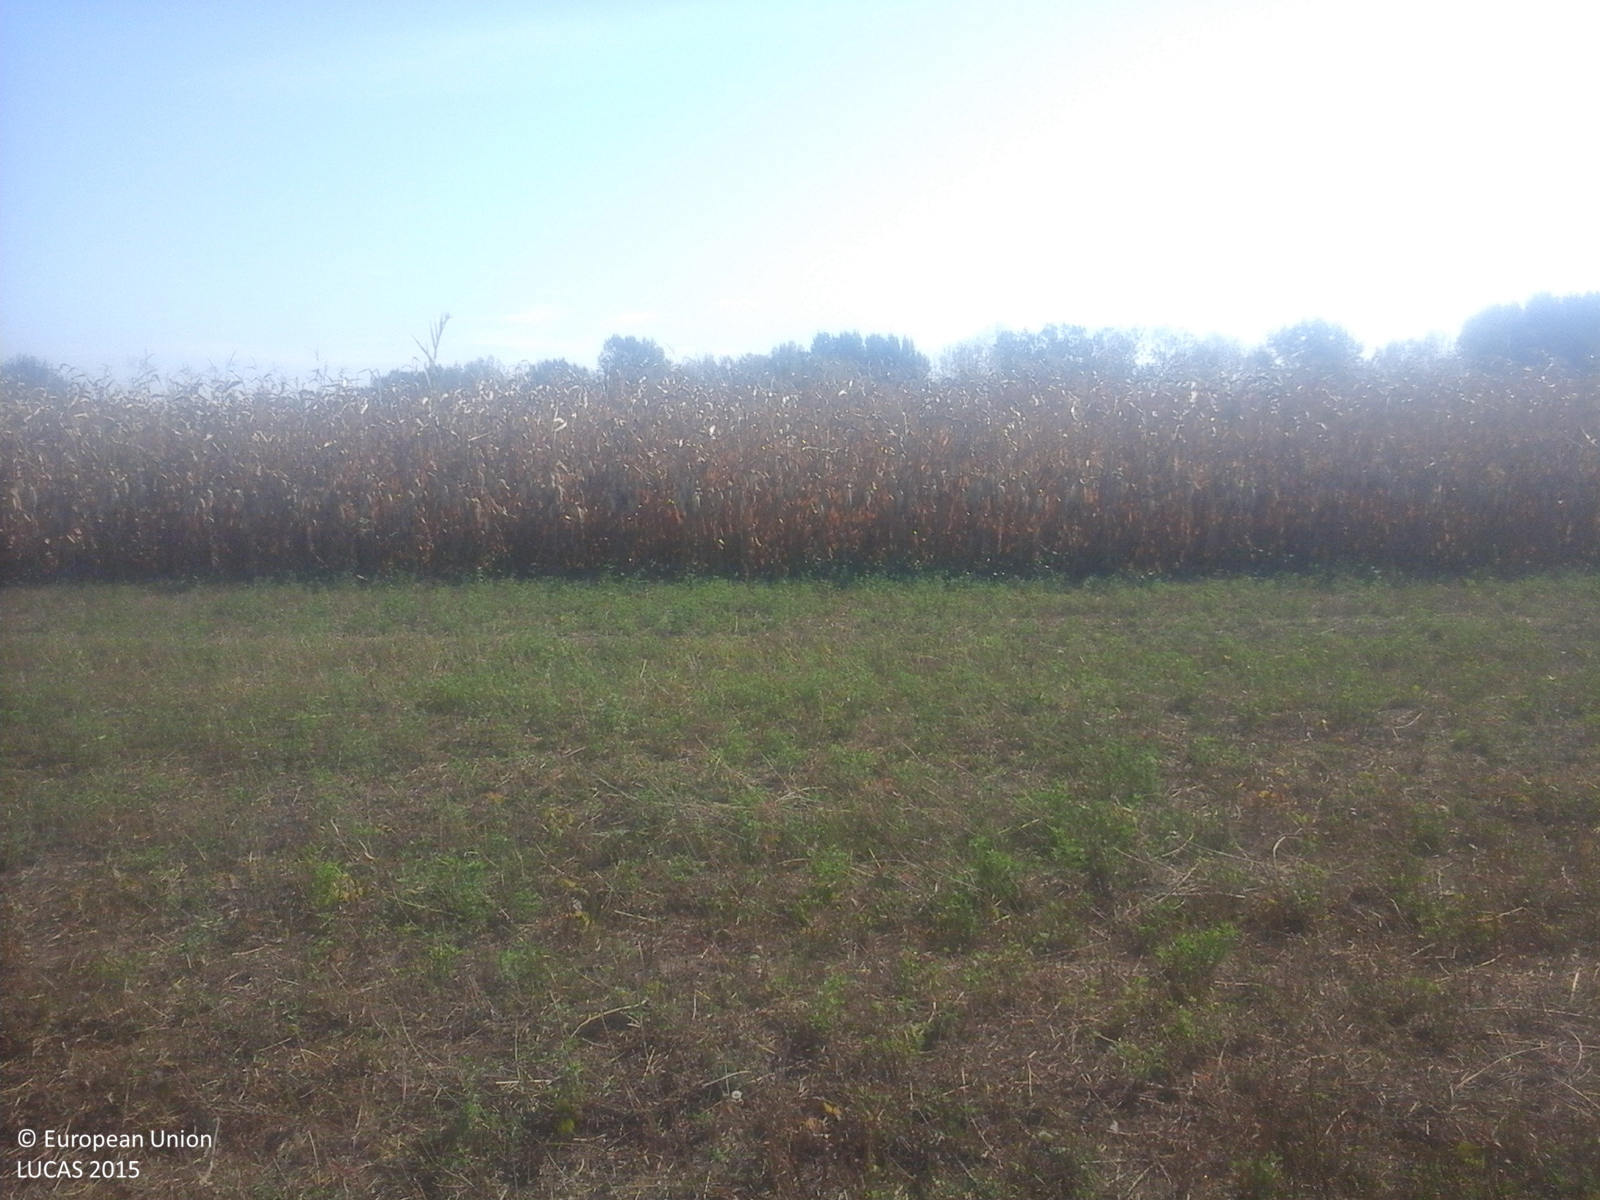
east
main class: Cropland
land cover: Maize
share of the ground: > 75 %
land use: Agriculture (excluding fallow land and kitchen gardens)
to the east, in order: Maize; Ditches and canals; Shrubland with sparse tree cover; Shruby margins; Lucerne; Maize; Arable land (only in case pi); Tracks; Spontaneously vegetated surfaces; Inland fresh running water
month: September
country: RO
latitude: 47.7999
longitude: 22.8140
